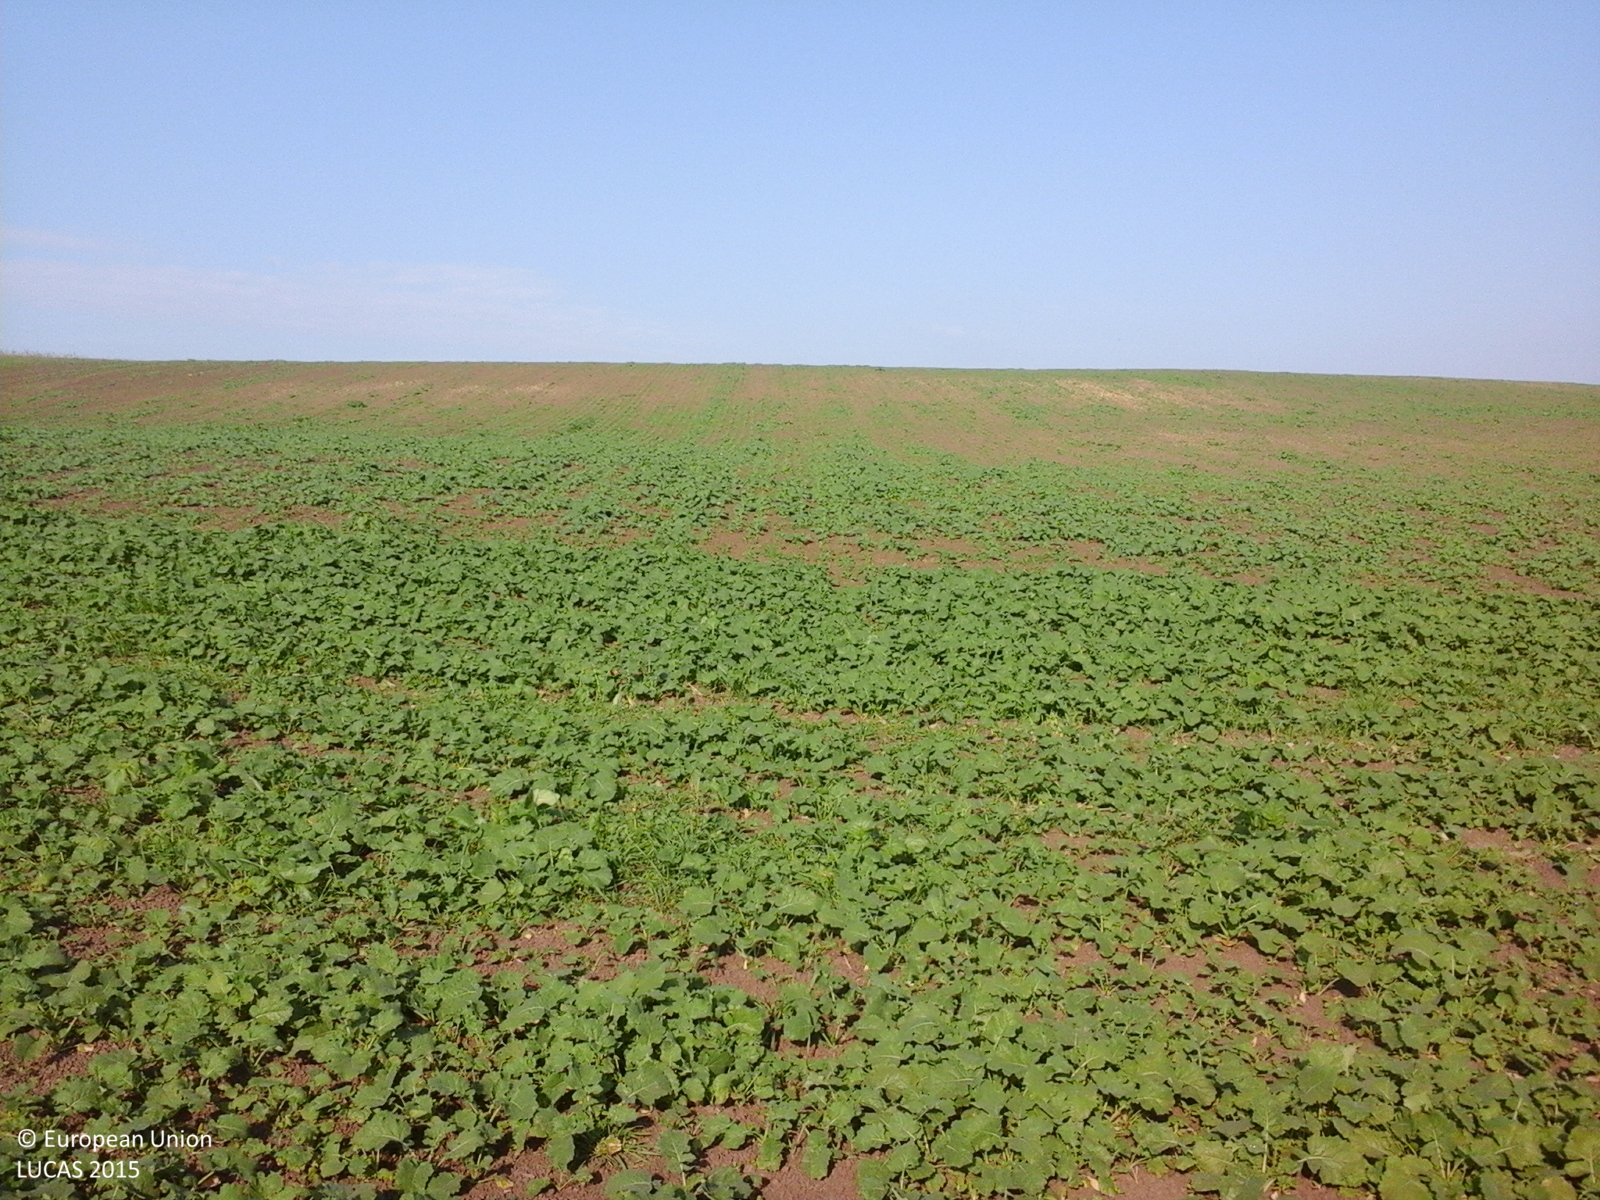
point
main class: Cropland
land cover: Rape and turnip rape
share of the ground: > 75 %
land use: Agriculture (excluding fallow land and kitchen gardens)
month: October
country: RO
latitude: 46.5133
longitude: 24.1960
